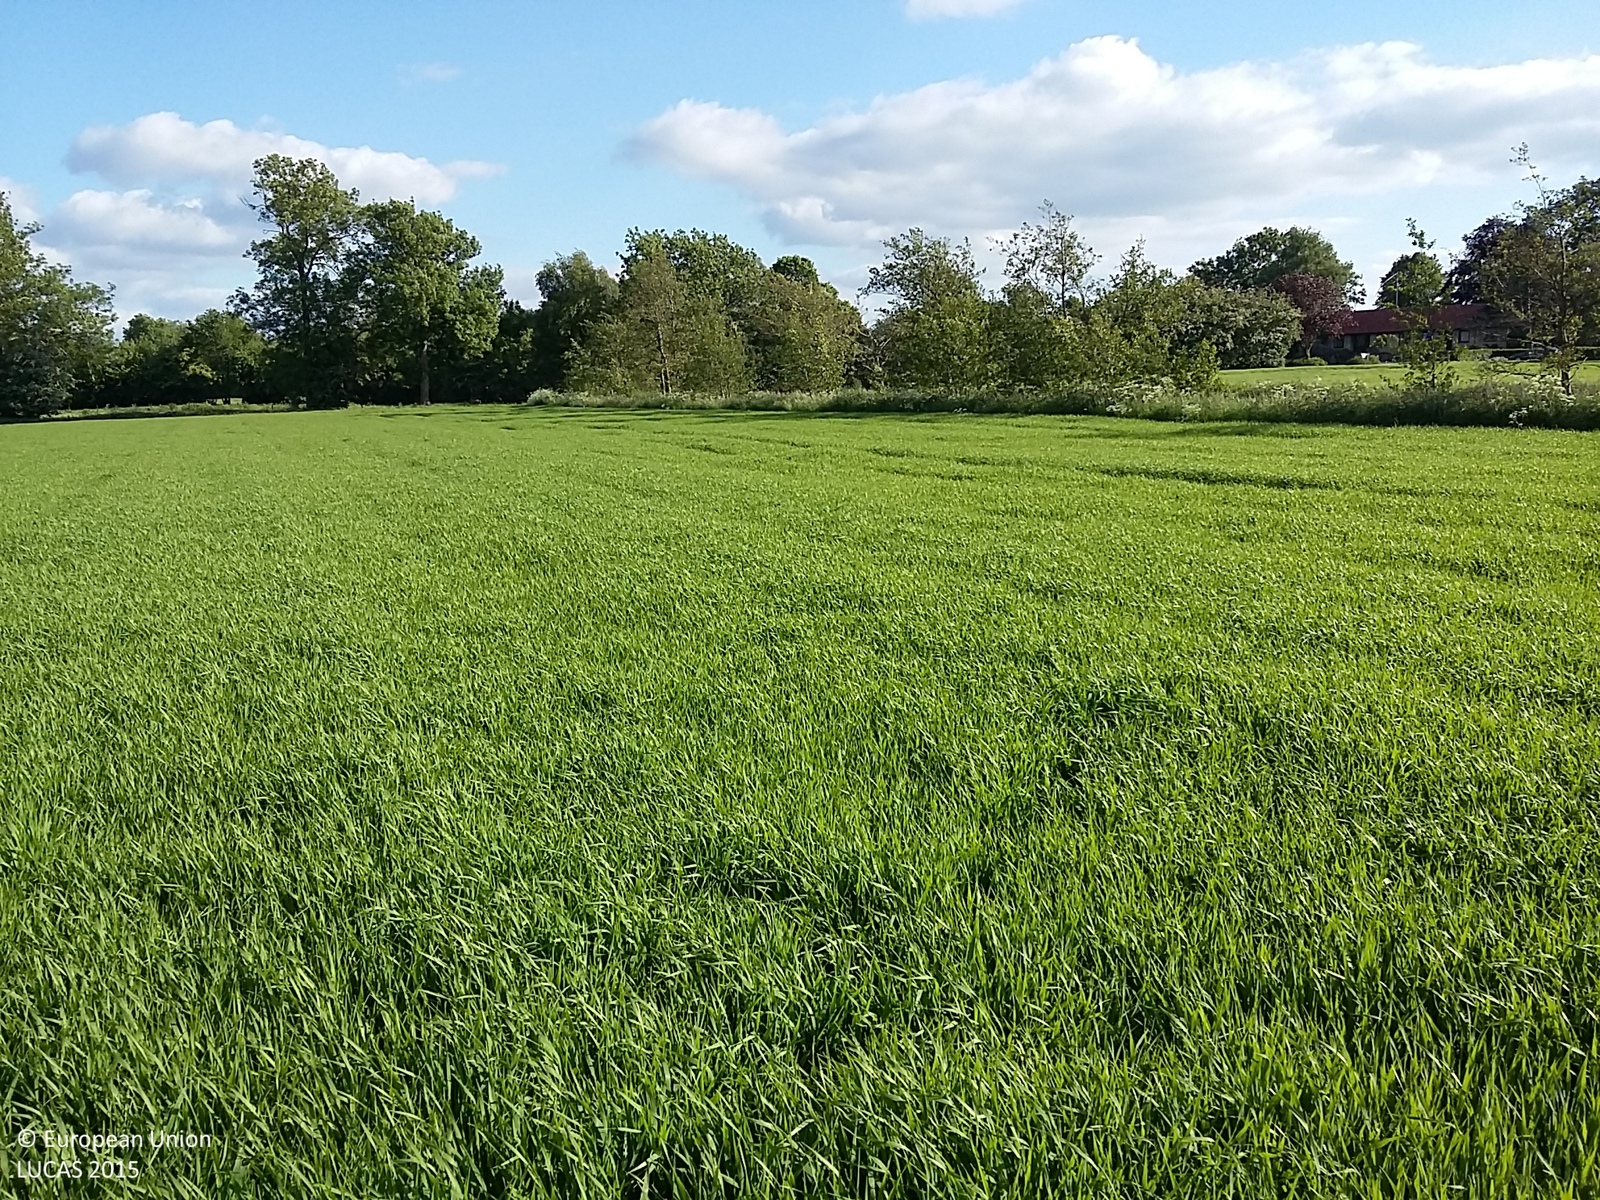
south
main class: Cropland
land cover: Barley
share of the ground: > 75 %
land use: Agriculture (excluding fallow land and kitchen gardens)
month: June
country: DK
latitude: 55.2153
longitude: 10.6753
